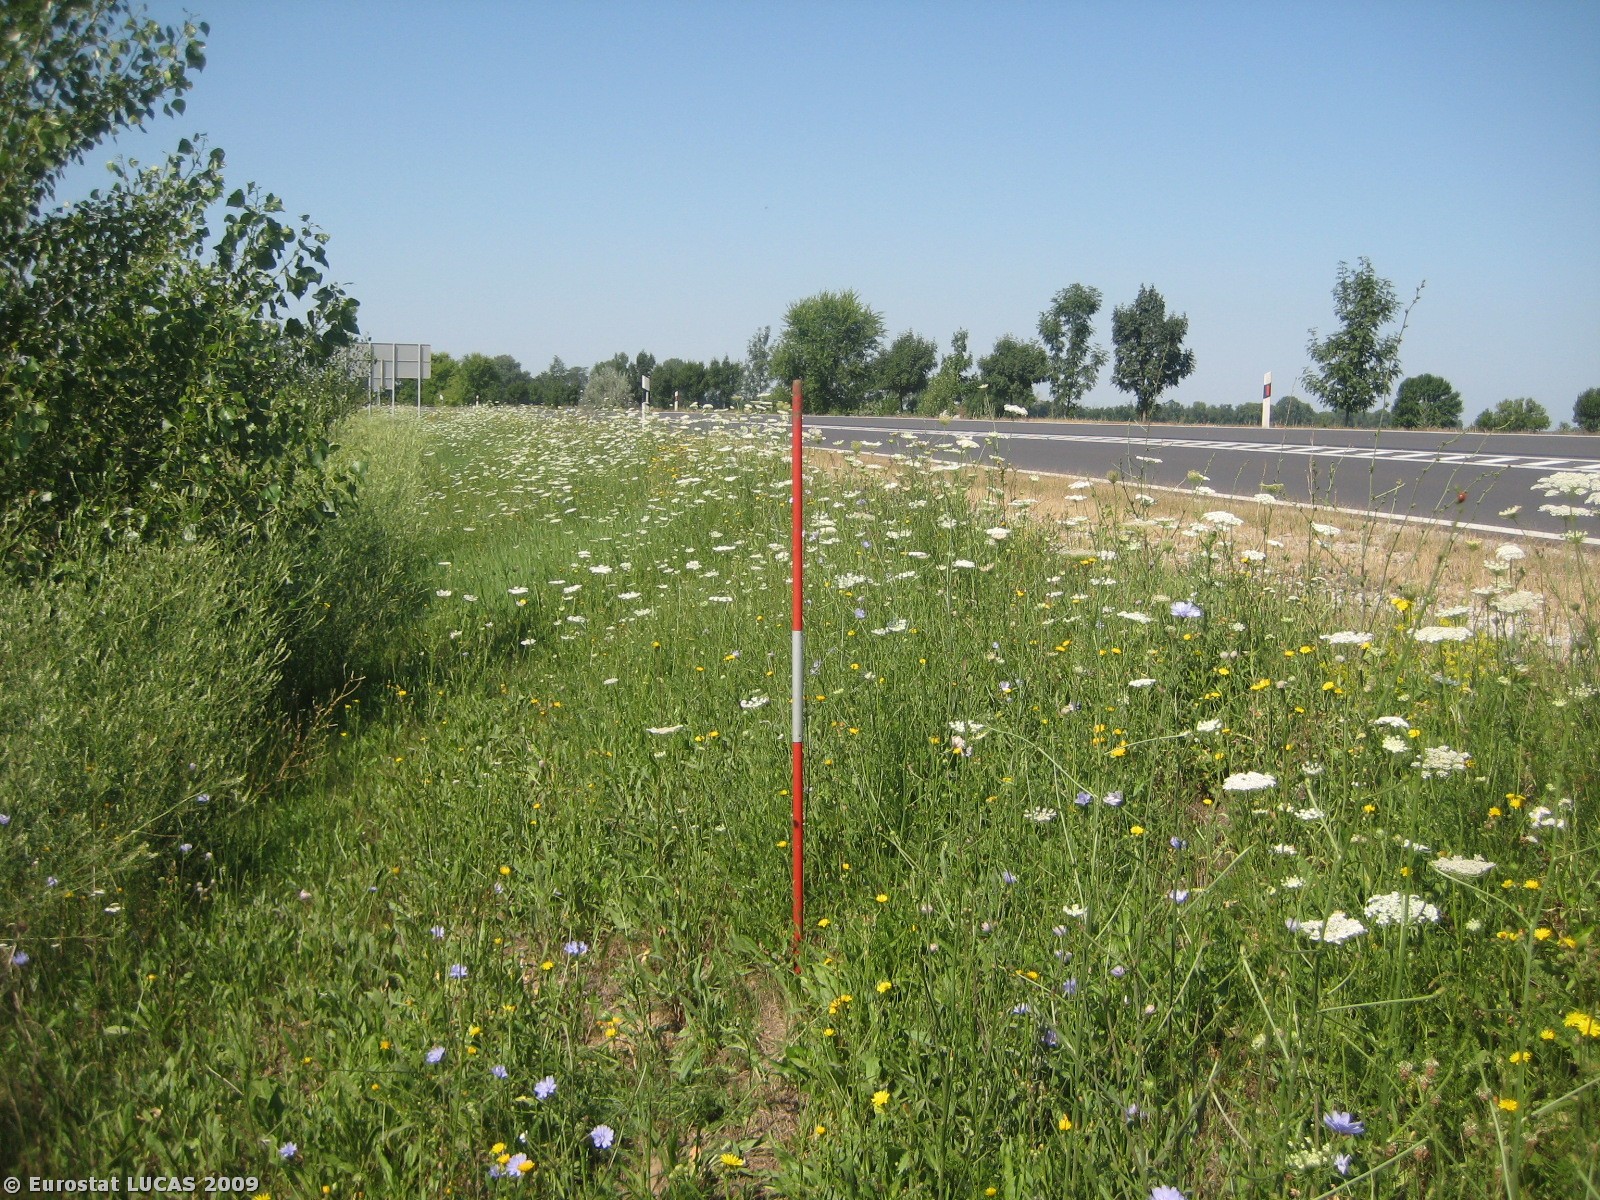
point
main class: Grassland
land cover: Spontaneously vegetated surfaces
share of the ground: 50 - 75 %
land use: Unused
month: July
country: HU
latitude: 47.1421
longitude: 21.7135
